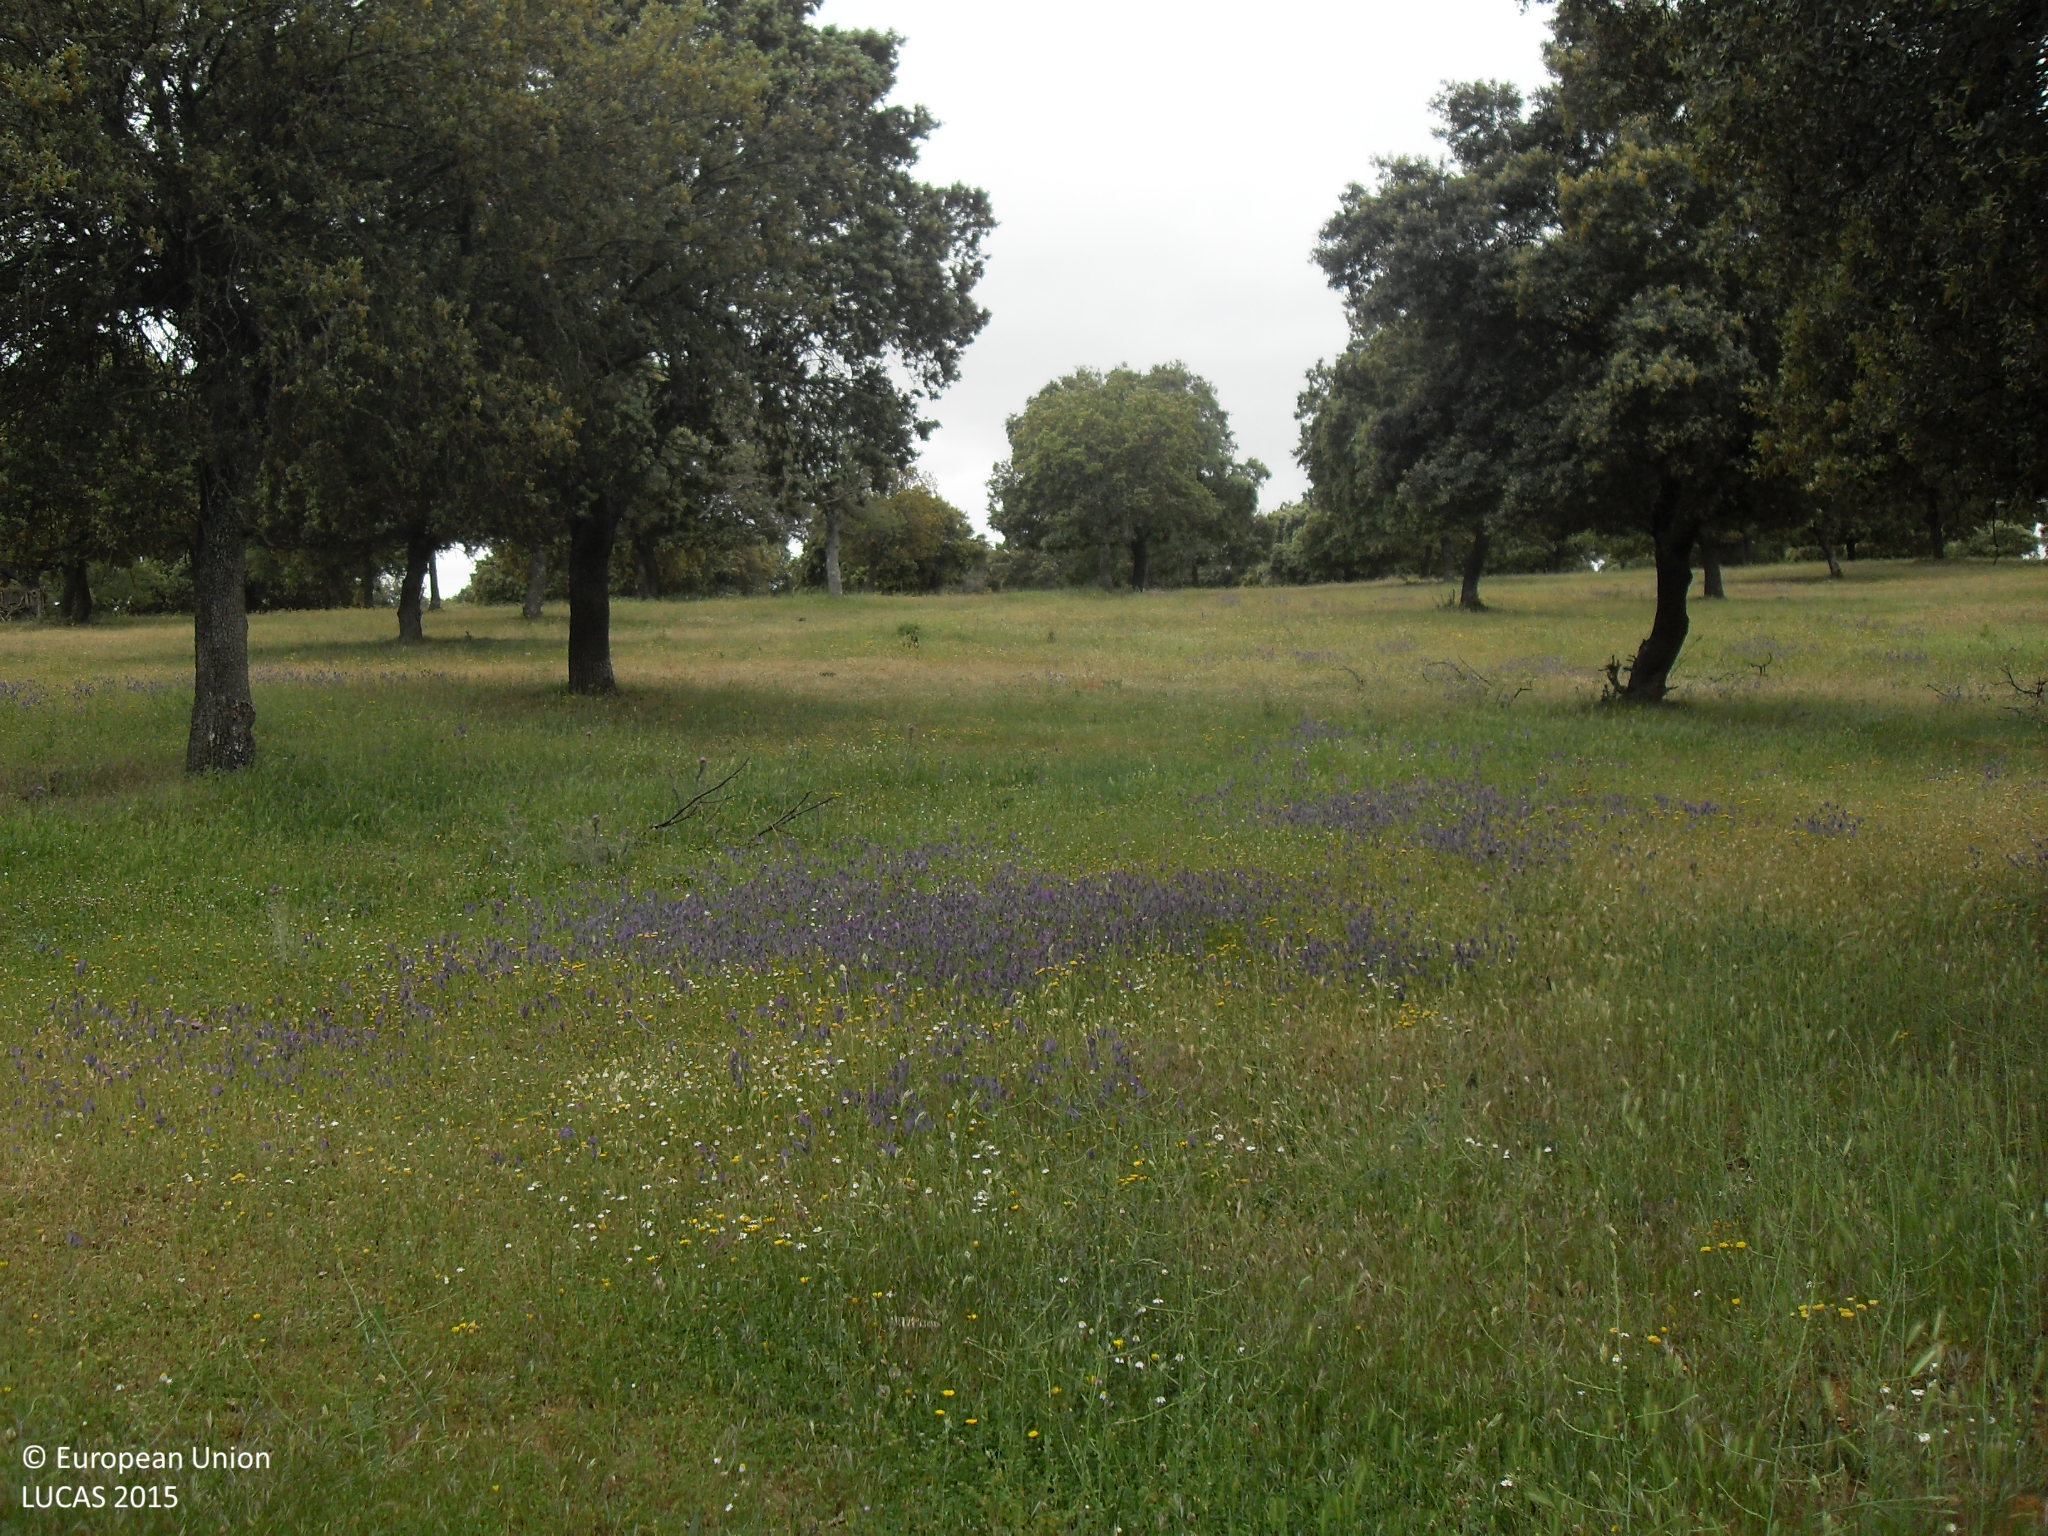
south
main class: Woodland
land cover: Broadleaved woodland
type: broadleaved evergreen forest
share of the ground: 25 - 50 %
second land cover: Grassland without tree/shrub cover
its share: 50 - 75 %
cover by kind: herbaceous plants 55 %, broadleaved forest trees 45 %
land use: Forestry
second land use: Agriculture (excluding fallow land and kitchen gardens)
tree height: > 5 m
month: May
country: ES
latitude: 40.7103
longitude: -5.6626
